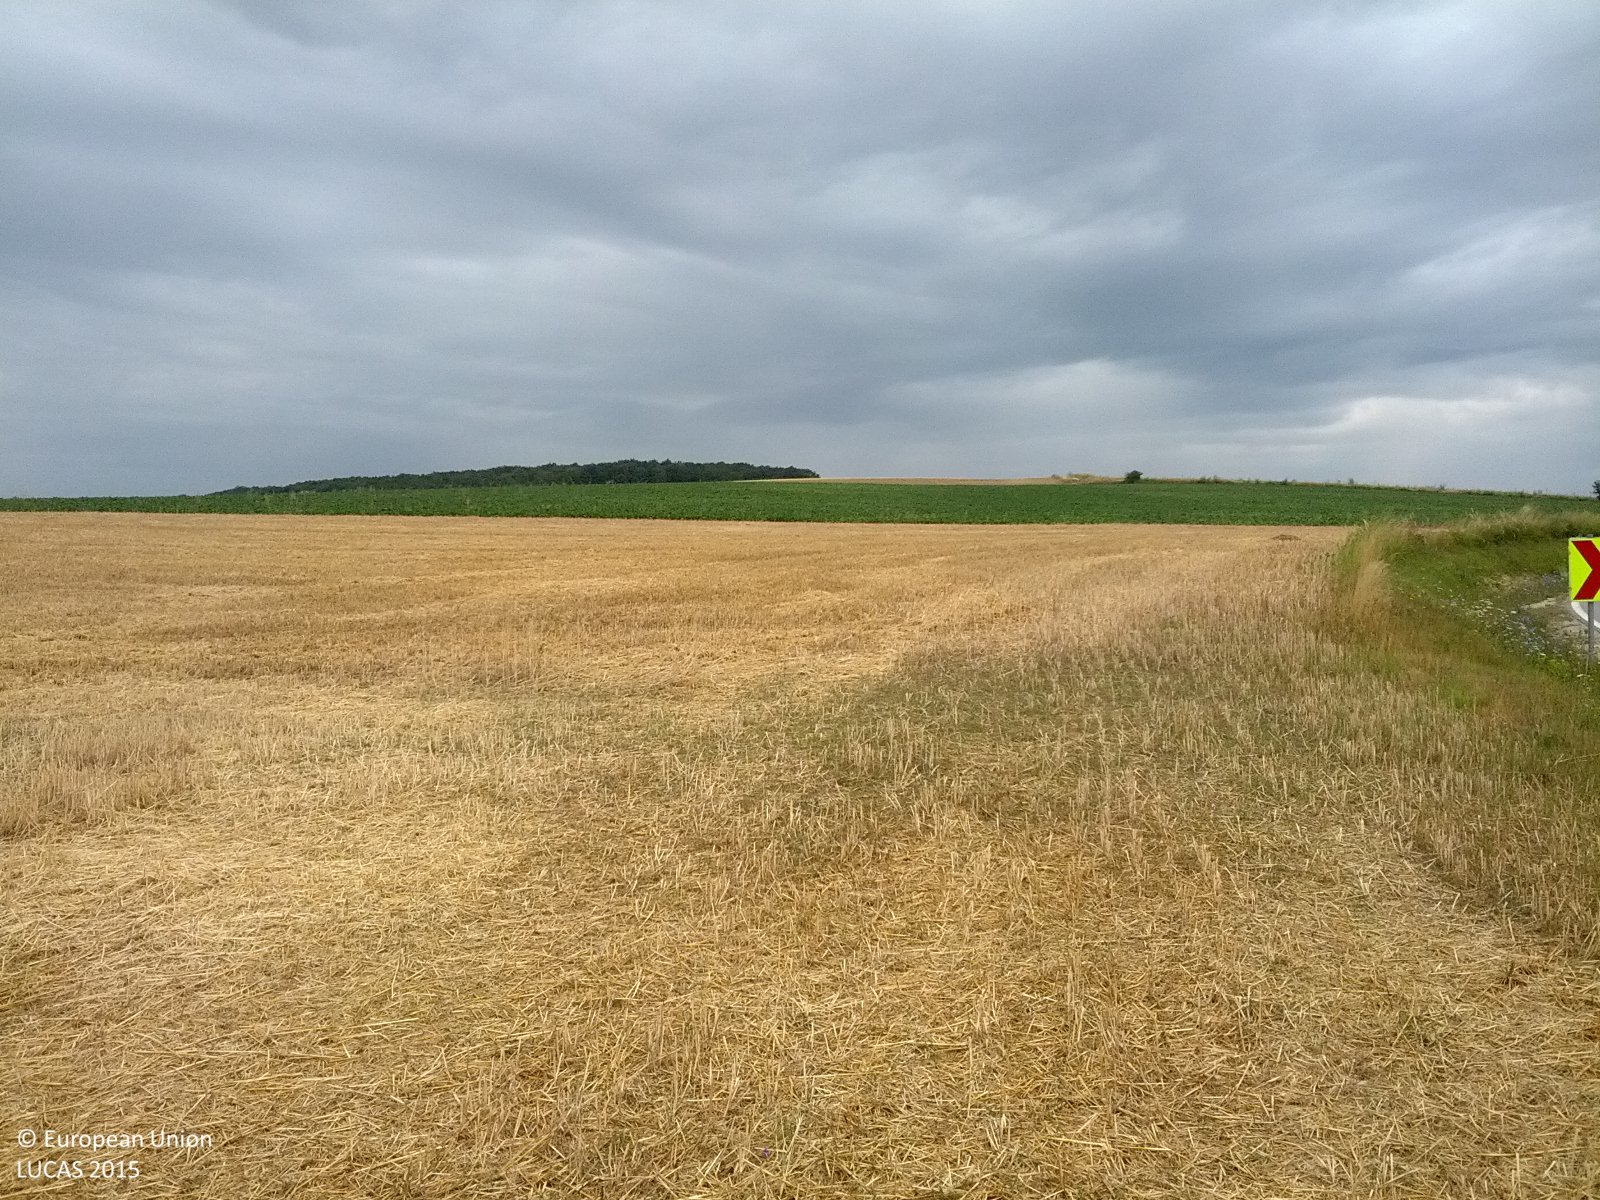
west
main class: Cropland
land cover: Common wheat
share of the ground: 10 - 25 %
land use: Agriculture (excluding fallow land and kitchen gardens)
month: July
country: AT
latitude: 48.6185
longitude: 16.3406
